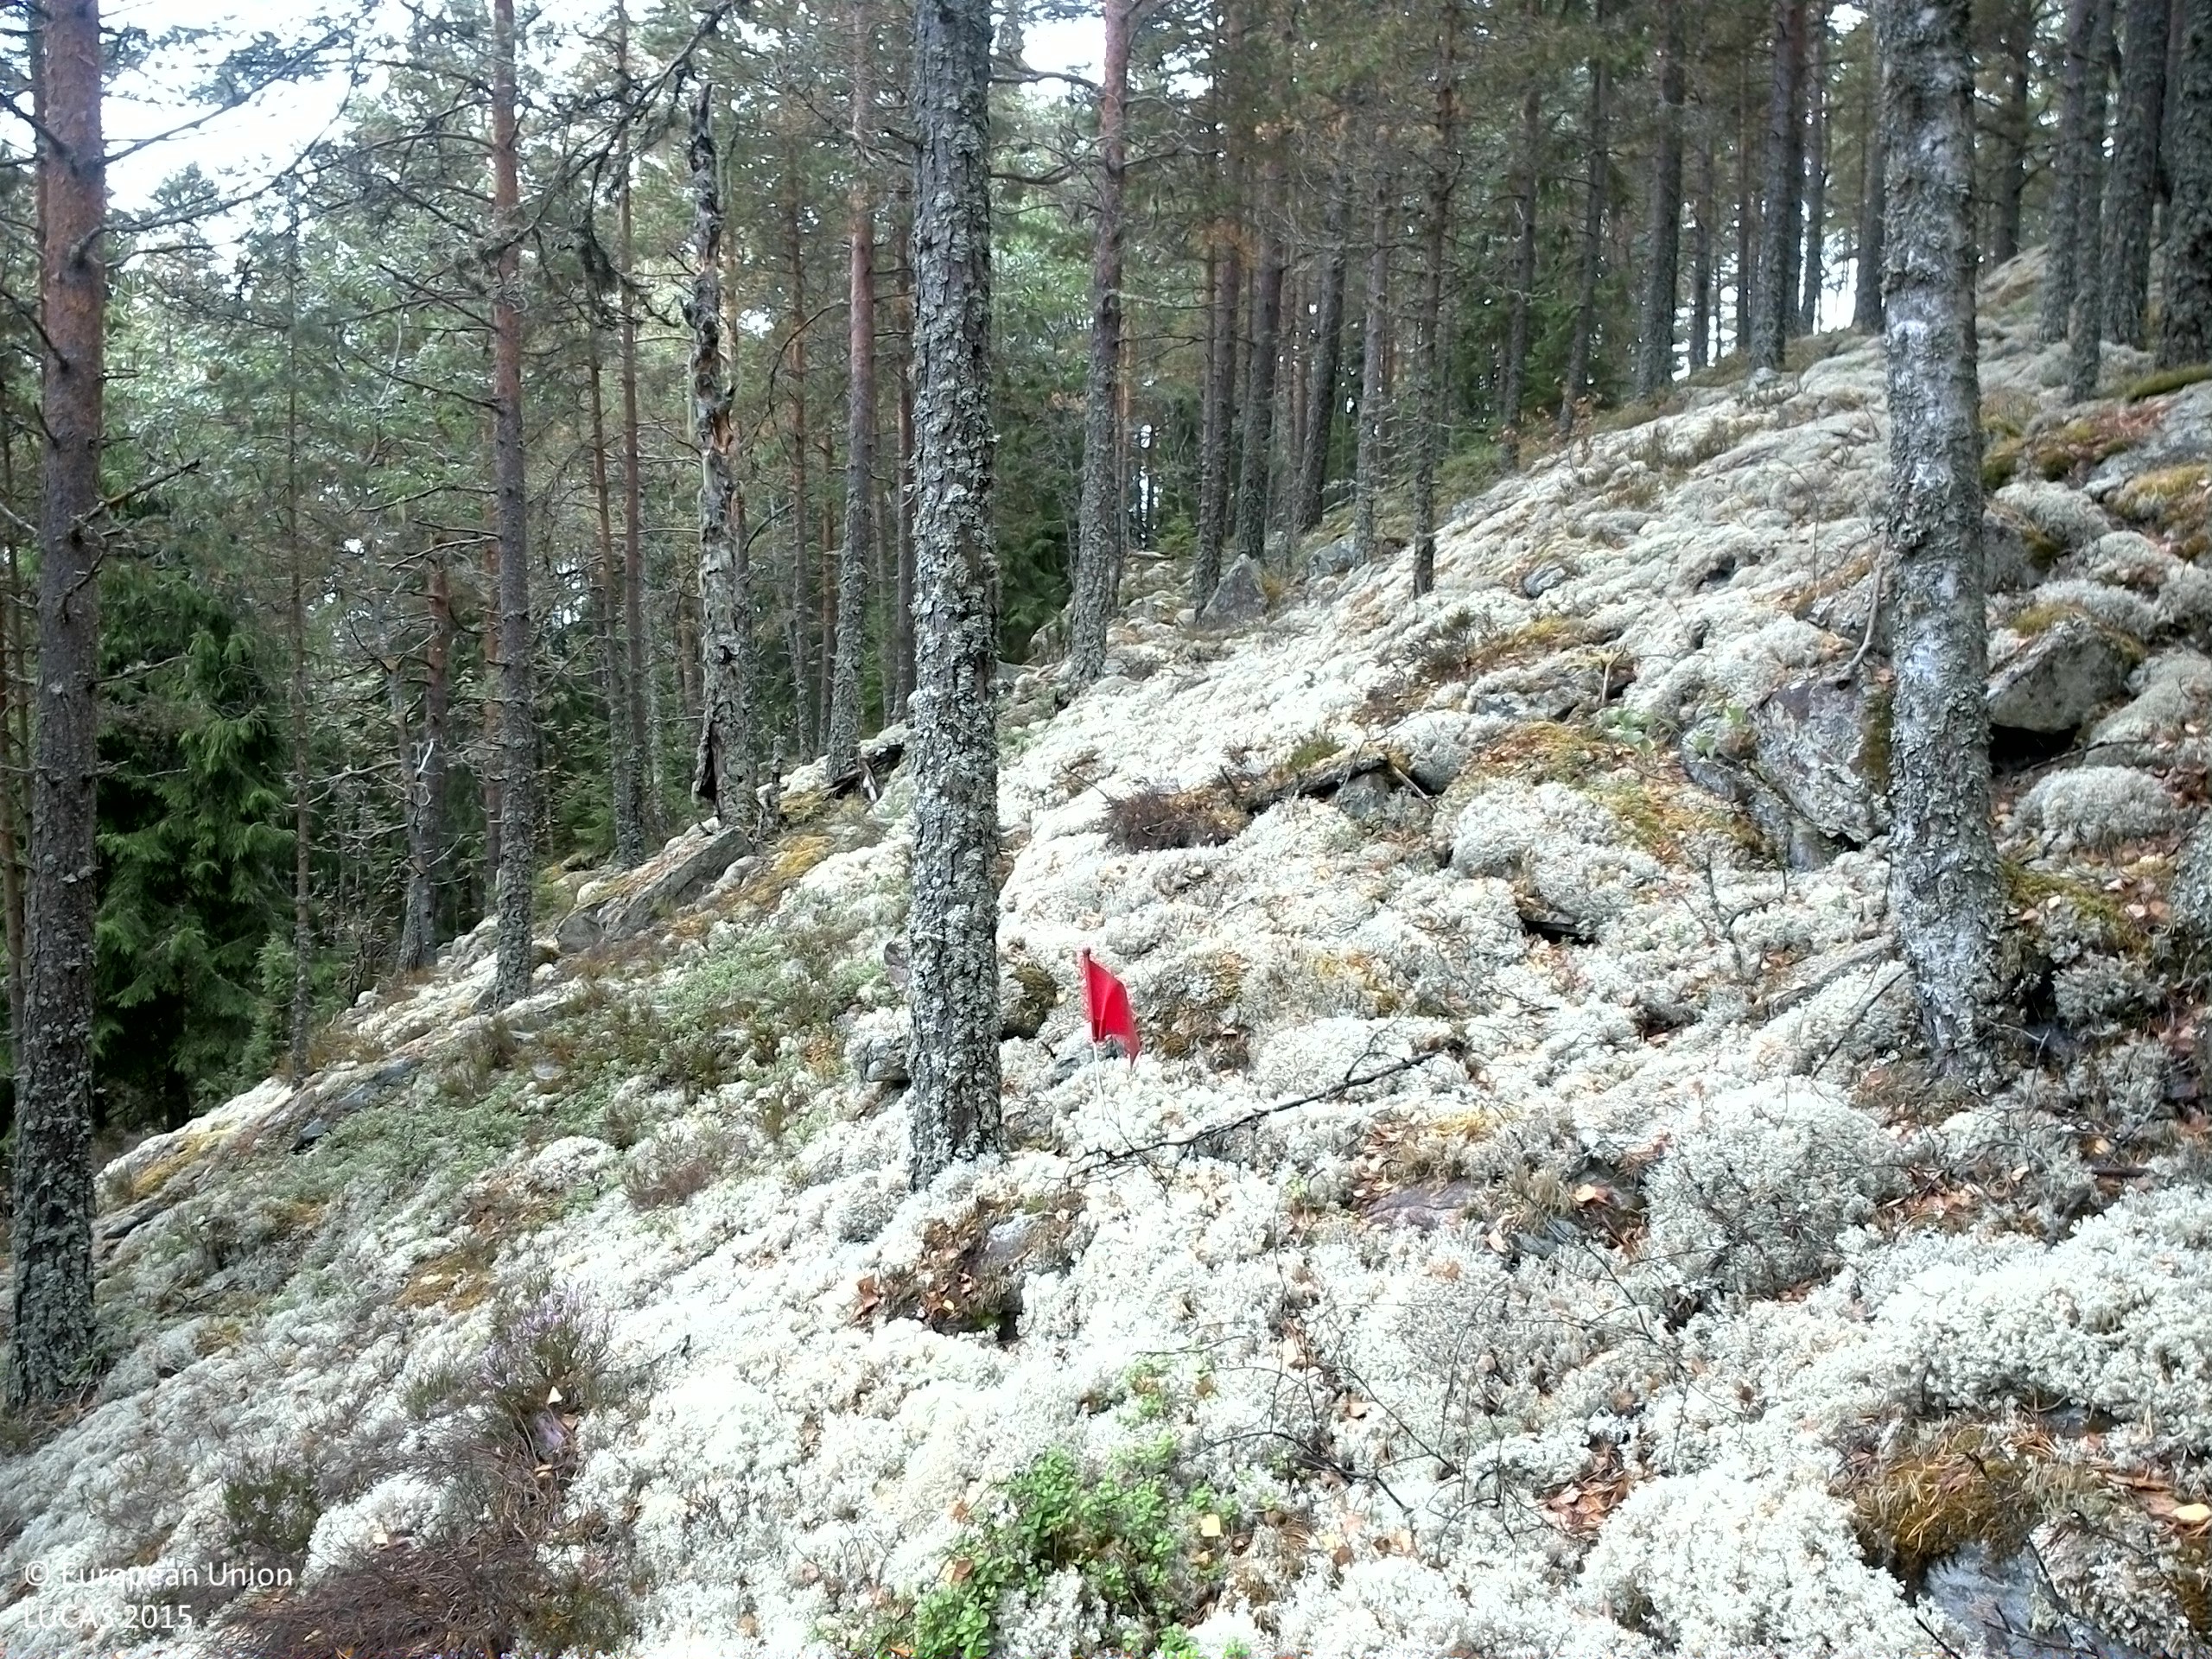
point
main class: Woodland
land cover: Pine dominated coniferous woodland
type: boreal forest
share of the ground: 50 - 75 %
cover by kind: coniferous forest trees 70 %, lichens and mosses 20 %, broadleaved forest trees 5 %, shrubs 5 %
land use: Forestry
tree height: > 5 m
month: September
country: SE
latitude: 59.7820
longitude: 13.2871
